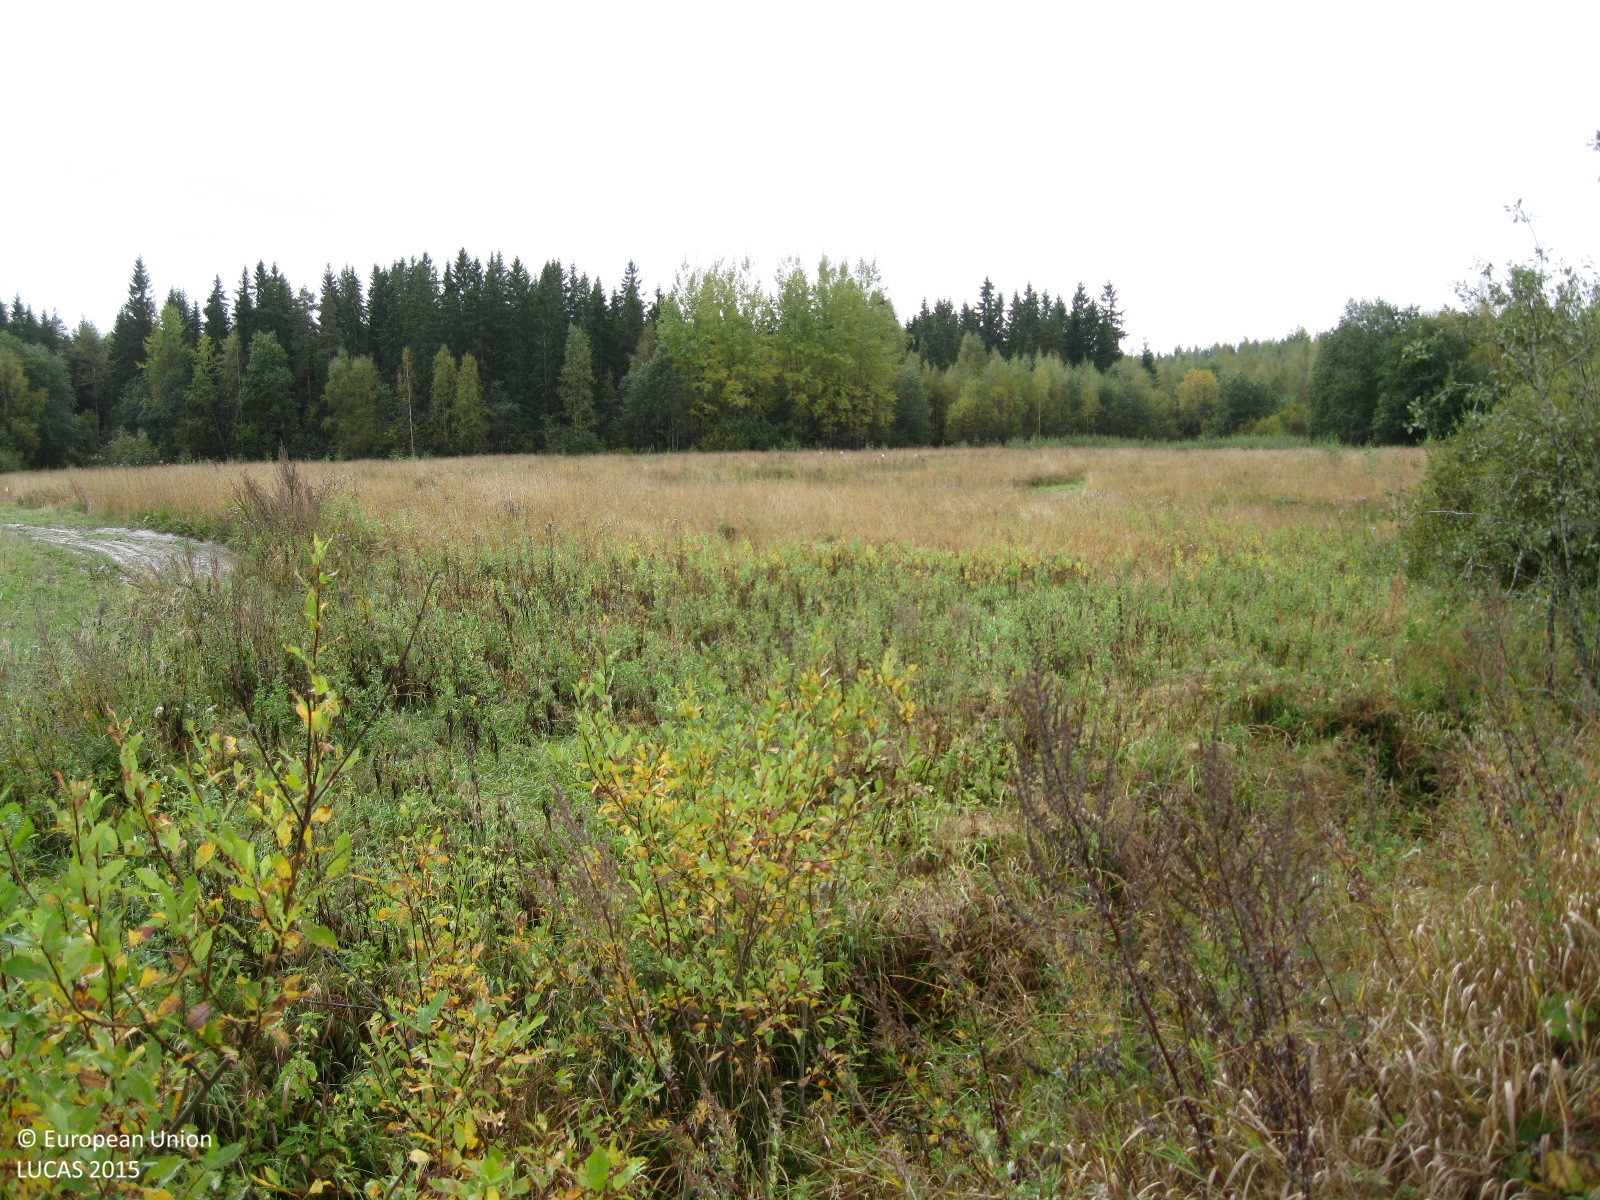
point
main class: Grassland
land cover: Spontaneously vegetated surfaces
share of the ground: > 75 %
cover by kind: herbaceous plants 100 %
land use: Sport
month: September
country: FI
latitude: 60.7698
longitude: 24.8161
